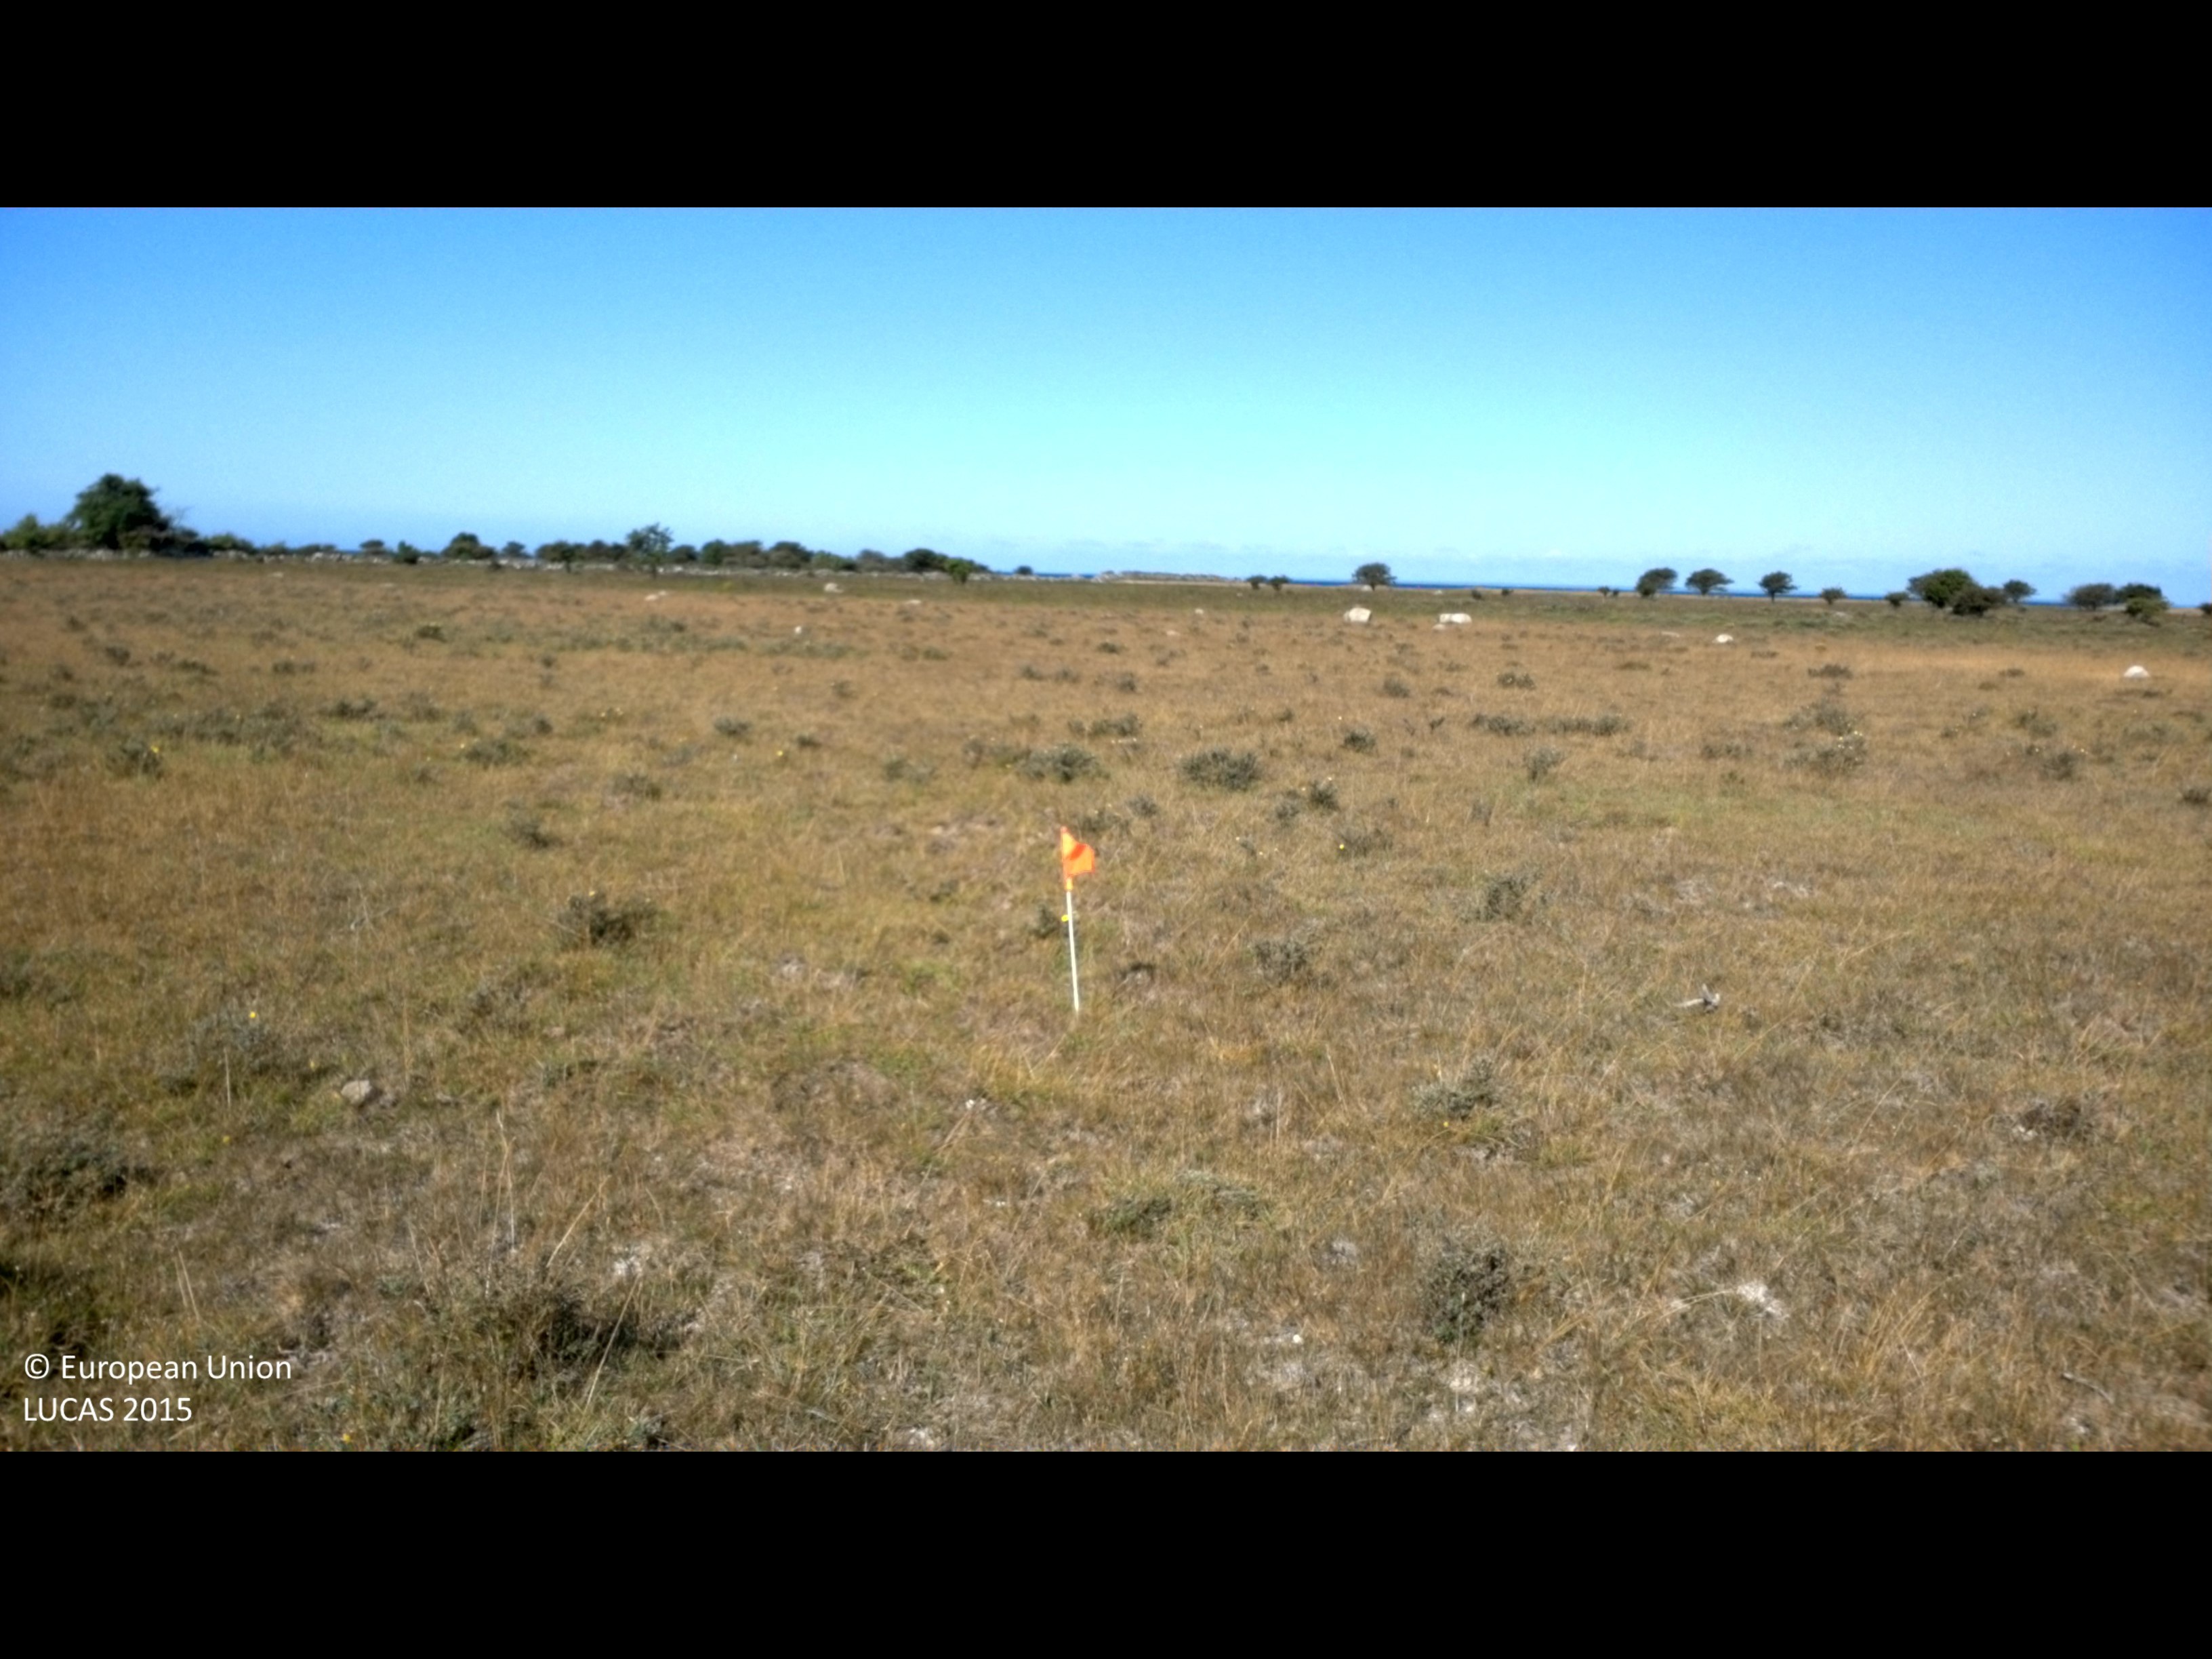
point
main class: Grassland
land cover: Grassland without tree/shrub cover
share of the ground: > 75 %
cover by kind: herbaceous plants 100 %
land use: Agriculture (excluding fallow land and kitchen gardens)
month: July
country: SE
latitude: 56.2263
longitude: 16.4054
